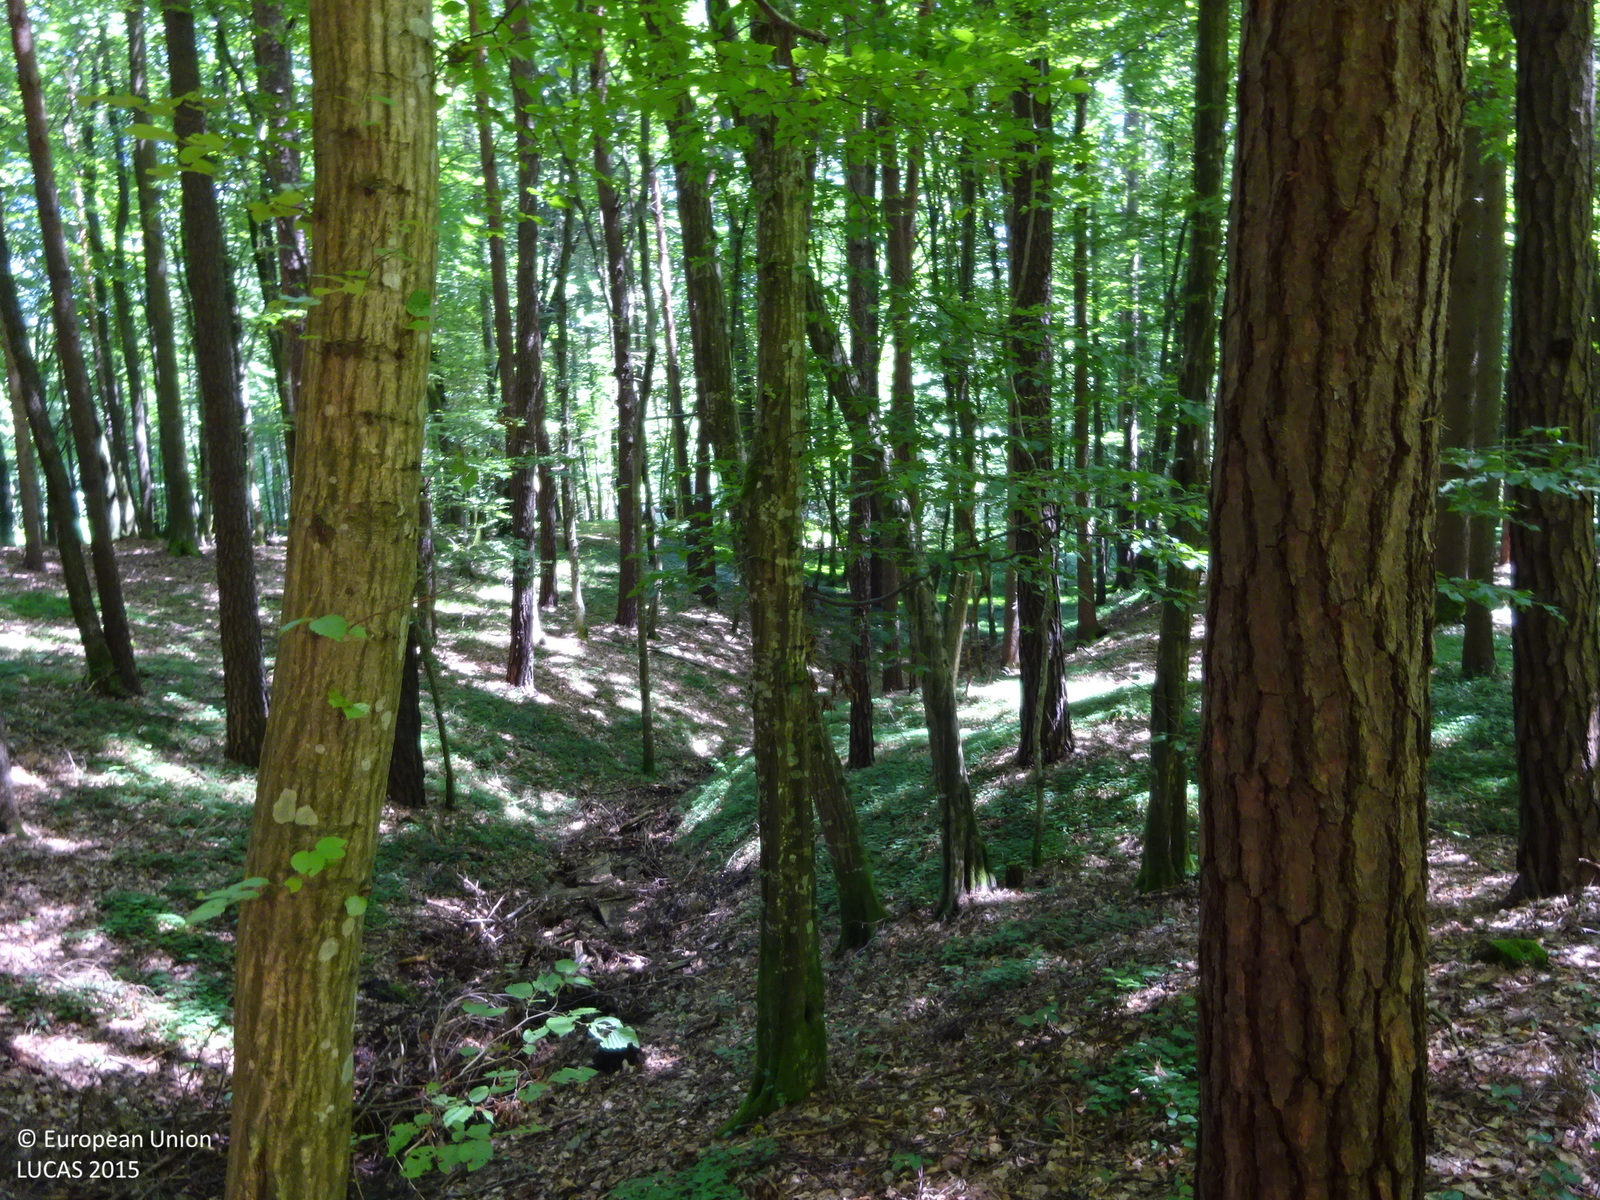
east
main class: Woodland
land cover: Other mixed woodland
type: mountainous beech forest
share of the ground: > 75 %
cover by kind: broadleaved forest trees 70 %, coniferous forest trees 30 %
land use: Forestry
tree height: > 5 m
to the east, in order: Other mixed woodland; Broadleaved woodland; Ditches and canals; Paved roads, cycling and walking lanes; Grass margins; Maize
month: June
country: AT
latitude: 46.7615
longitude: 15.9839
